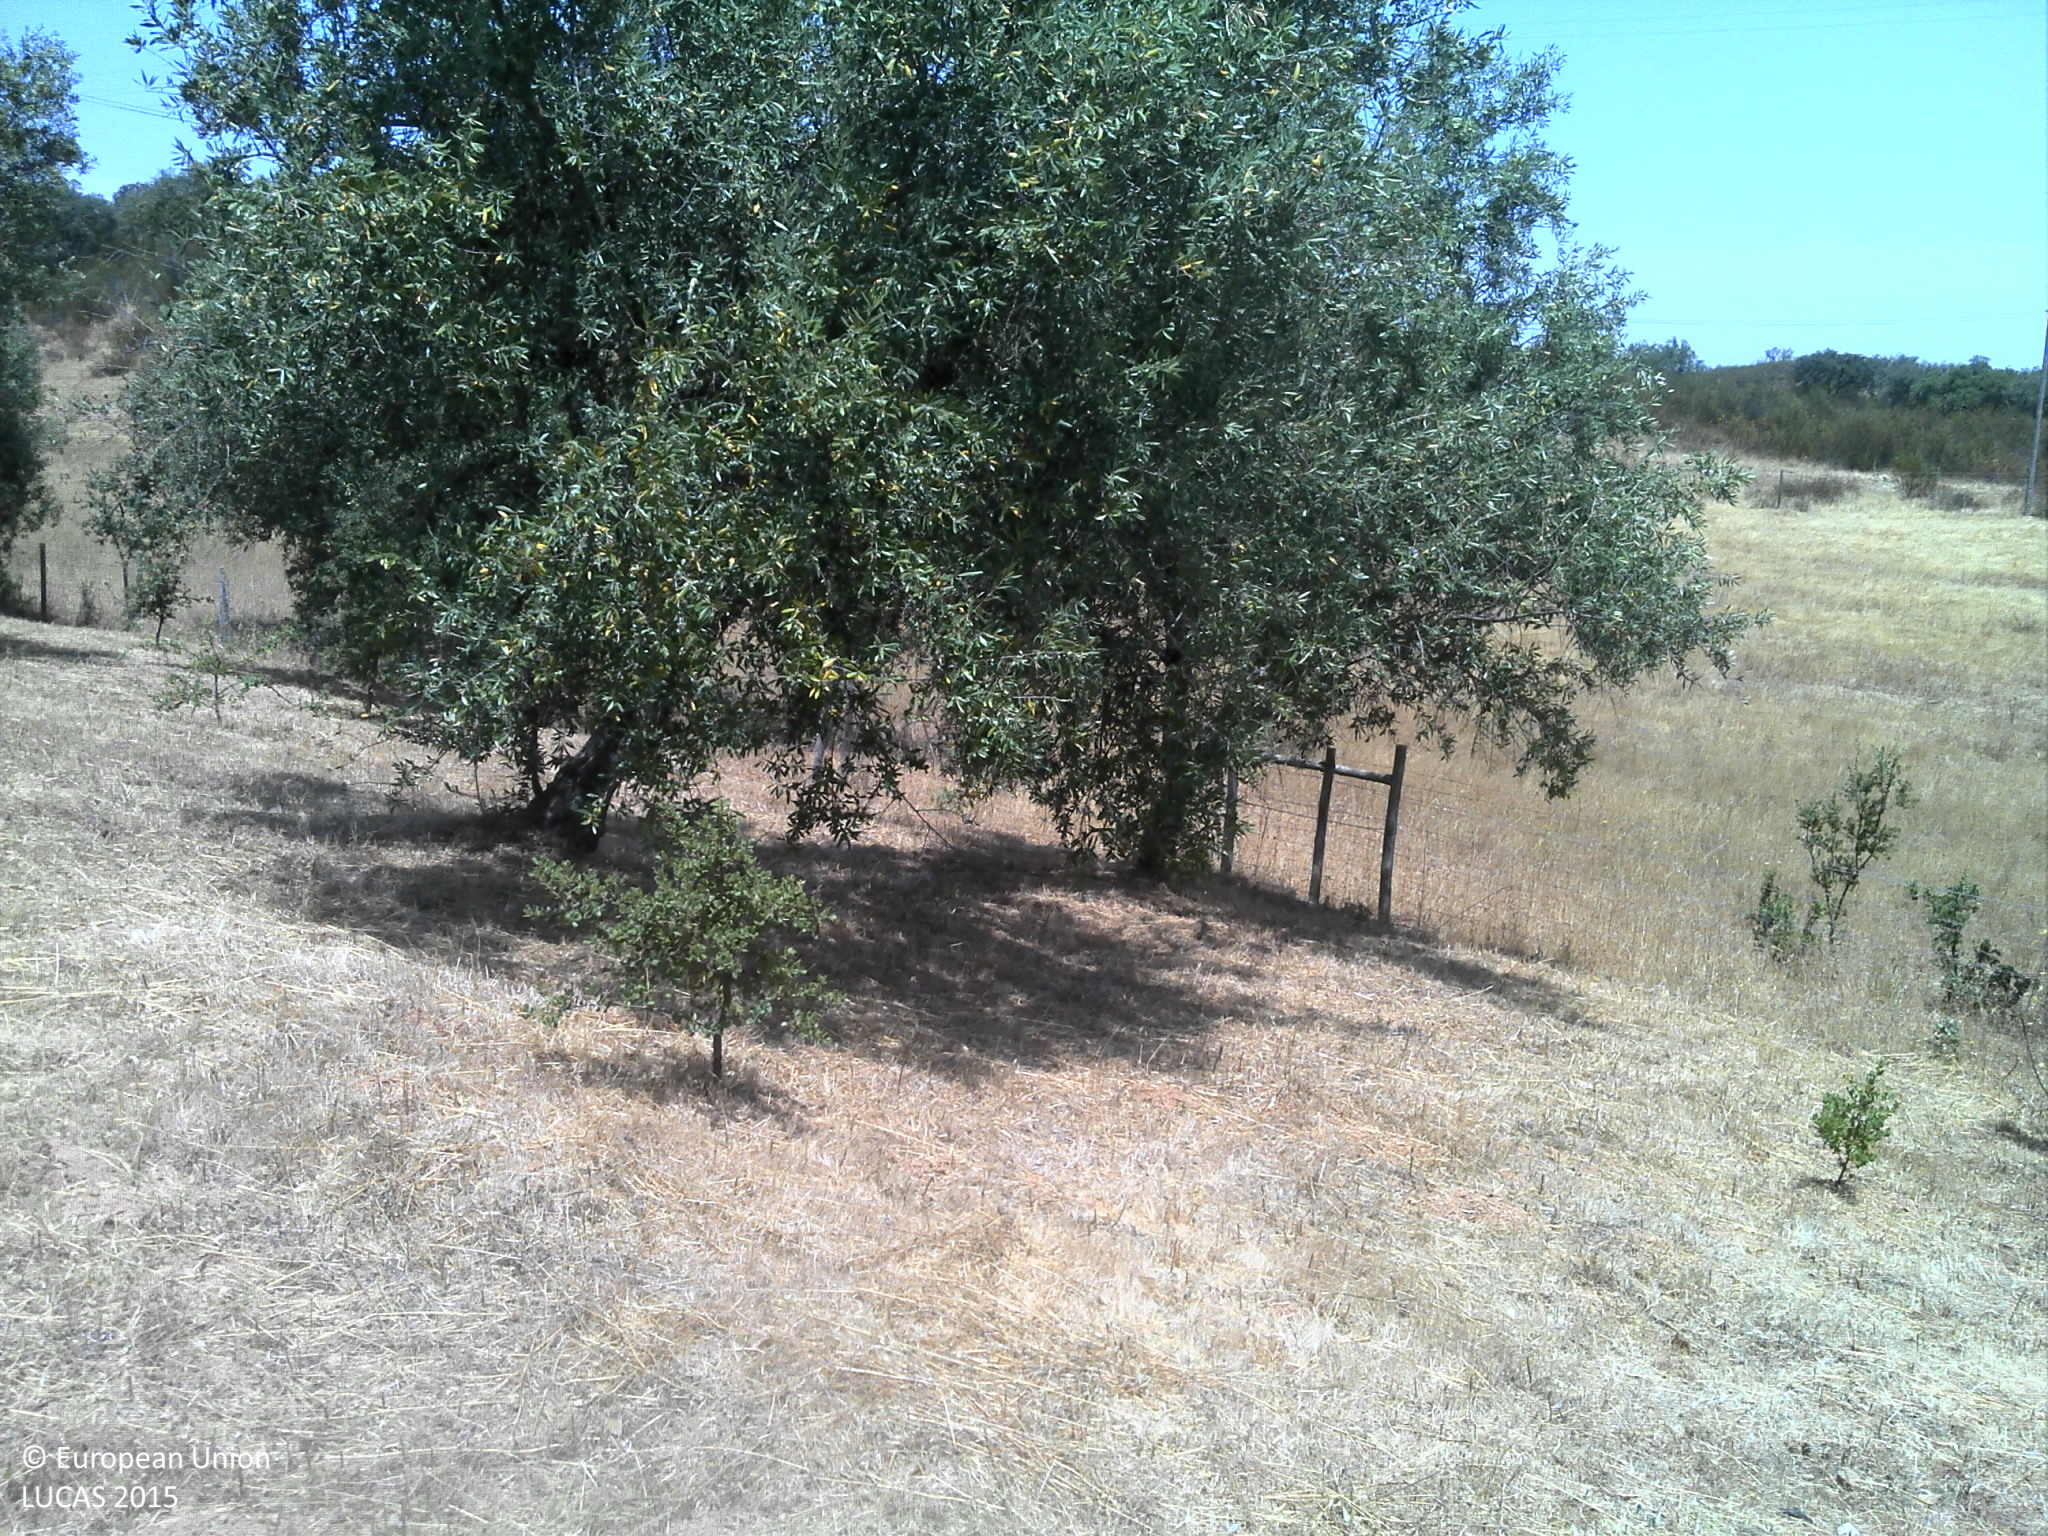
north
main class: Cropland
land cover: Olive groves
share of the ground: 10 - 25 %
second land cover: Grassland without tree/shrub cover
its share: 25 - 50 %
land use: Agriculture (excluding fallow land and kitchen gardens)
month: July
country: PT
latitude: 37.6258
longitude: -8.2833
